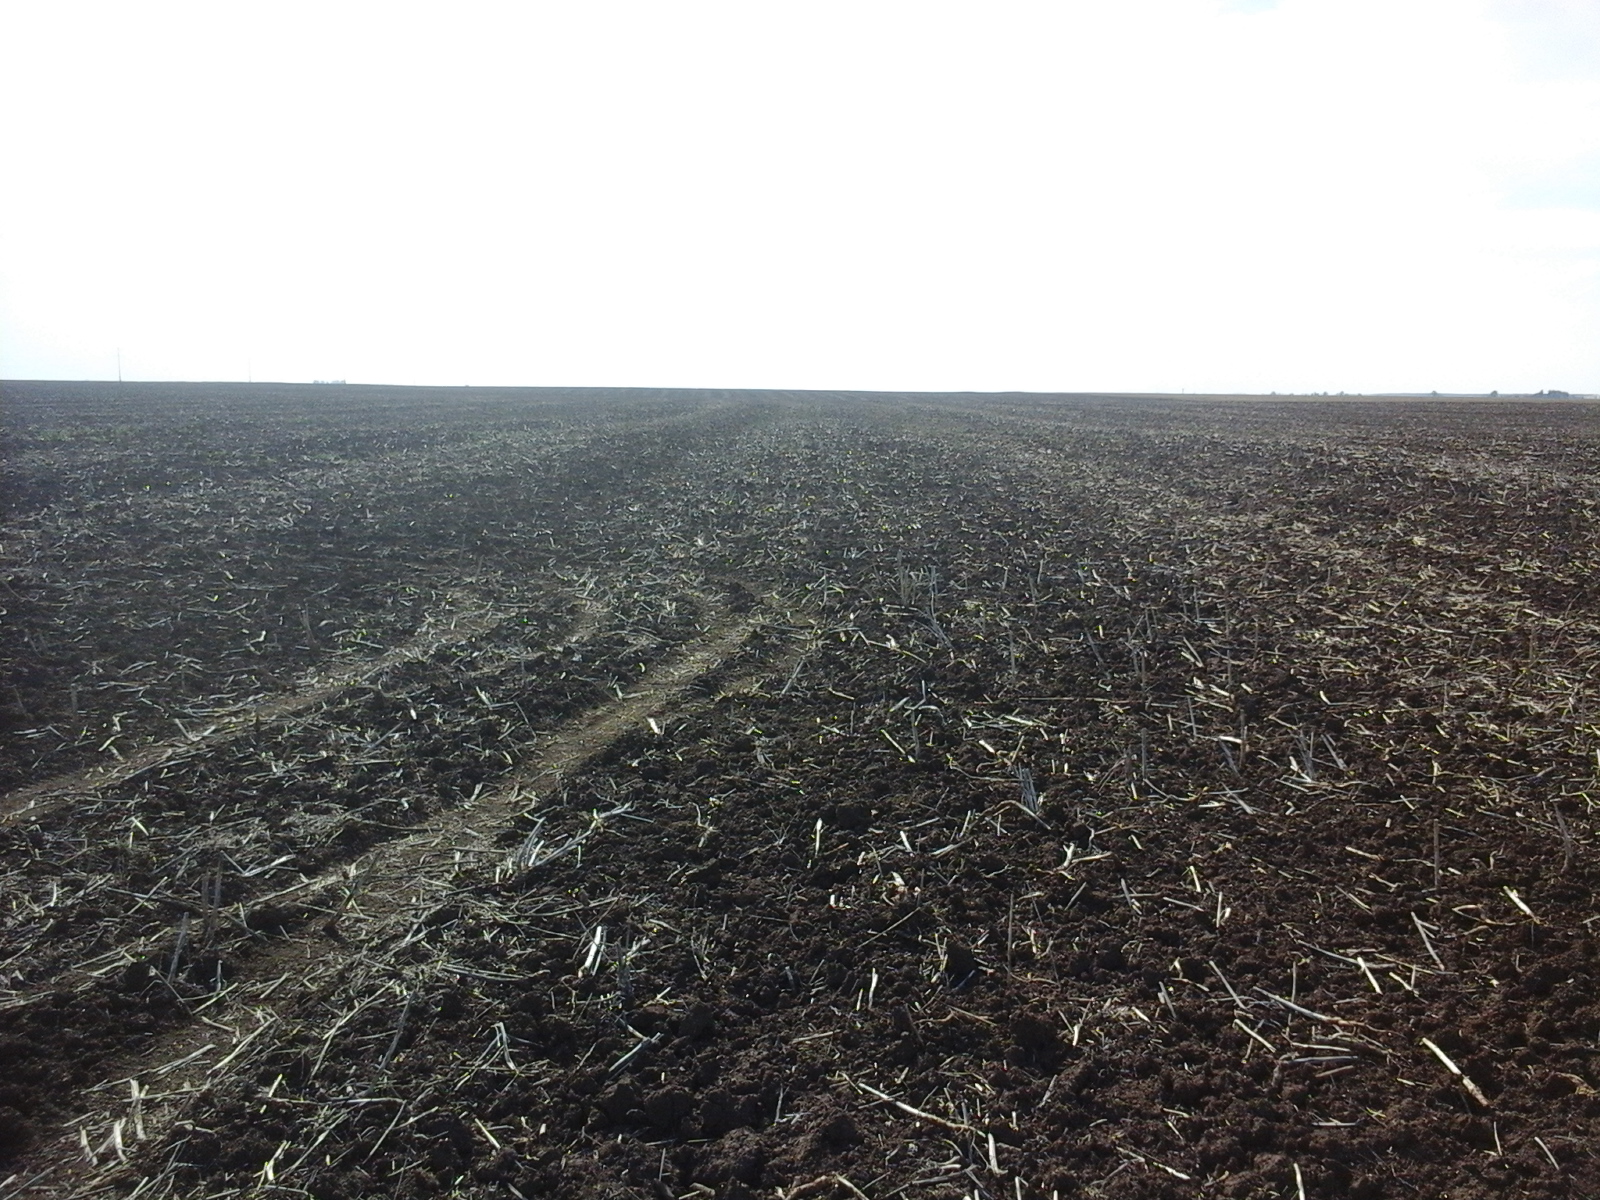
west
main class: Cropland
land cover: Rape and turnip rape
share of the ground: < 10 %
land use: Agriculture (excluding fallow land and kitchen gardens)
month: August
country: RO
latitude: 46.1163
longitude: 21.2776
